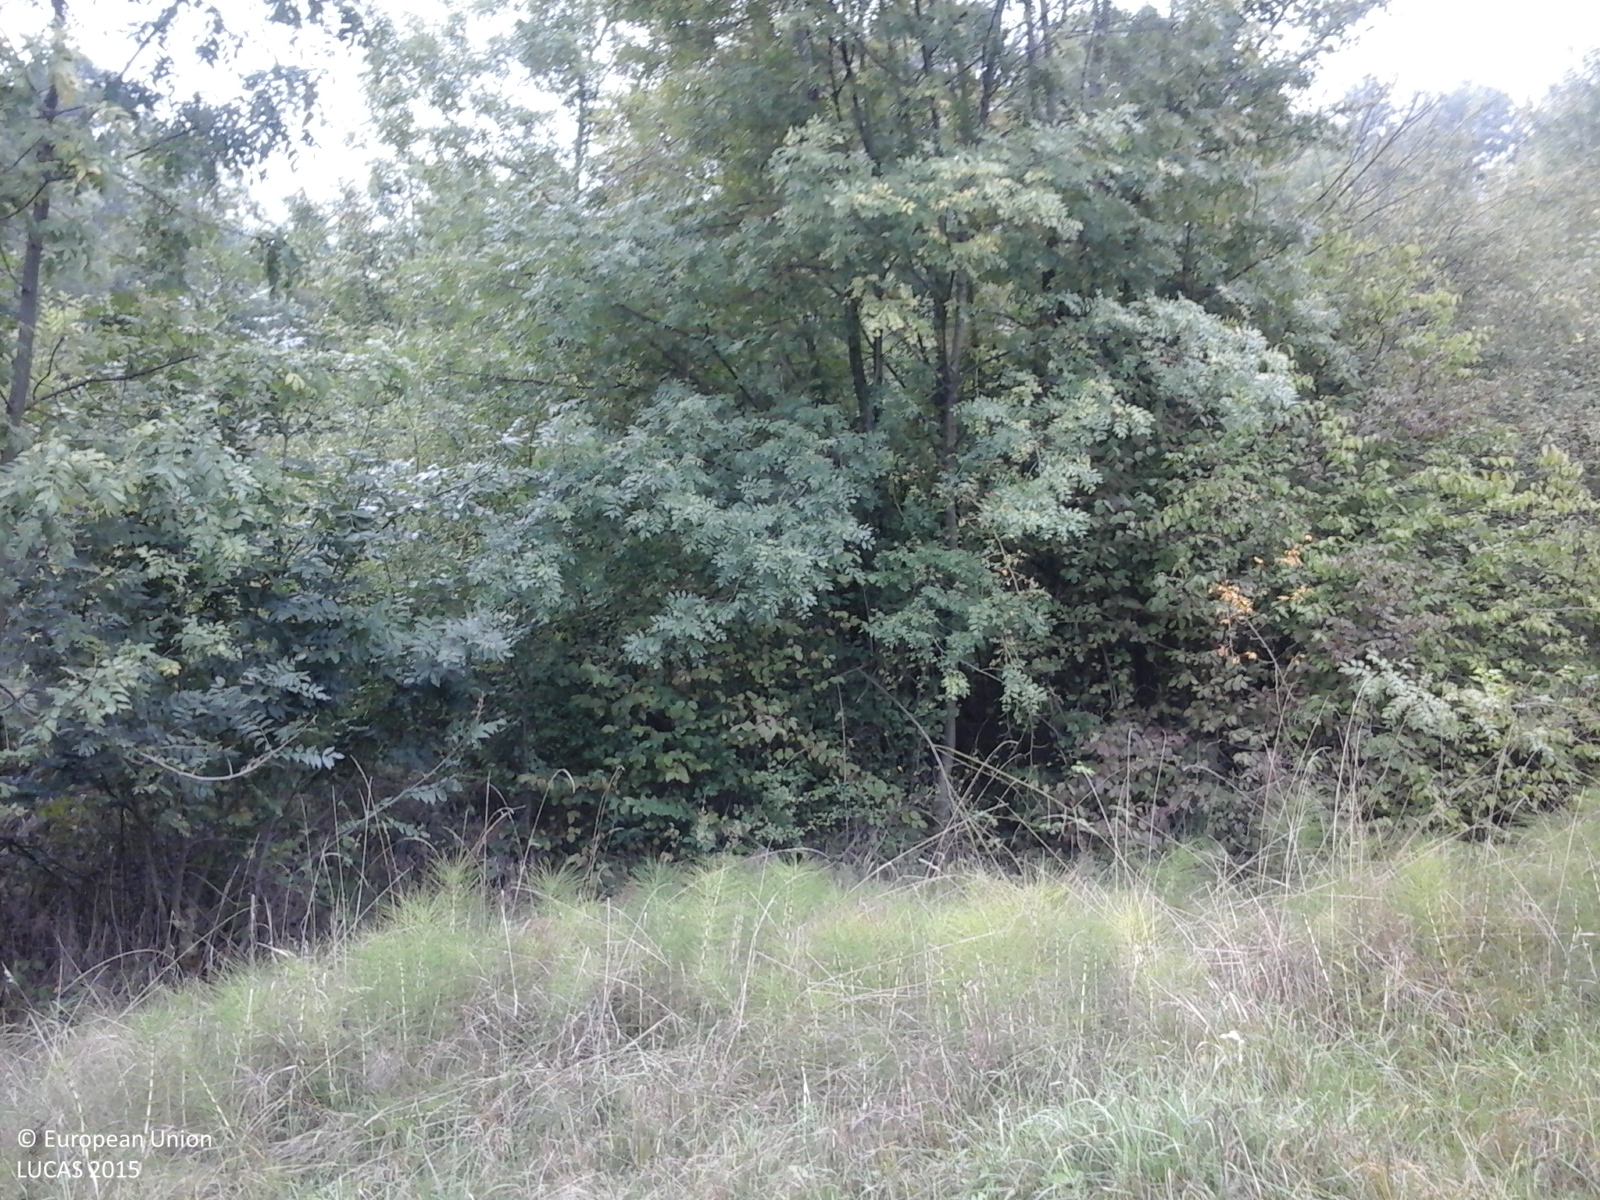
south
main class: Grassland
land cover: Spontaneously vegetated surfaces
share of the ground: > 75 %
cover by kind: herbaceous plants 100 %
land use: Fallow land
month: September
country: RO
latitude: 44.8198
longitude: 23.0362
